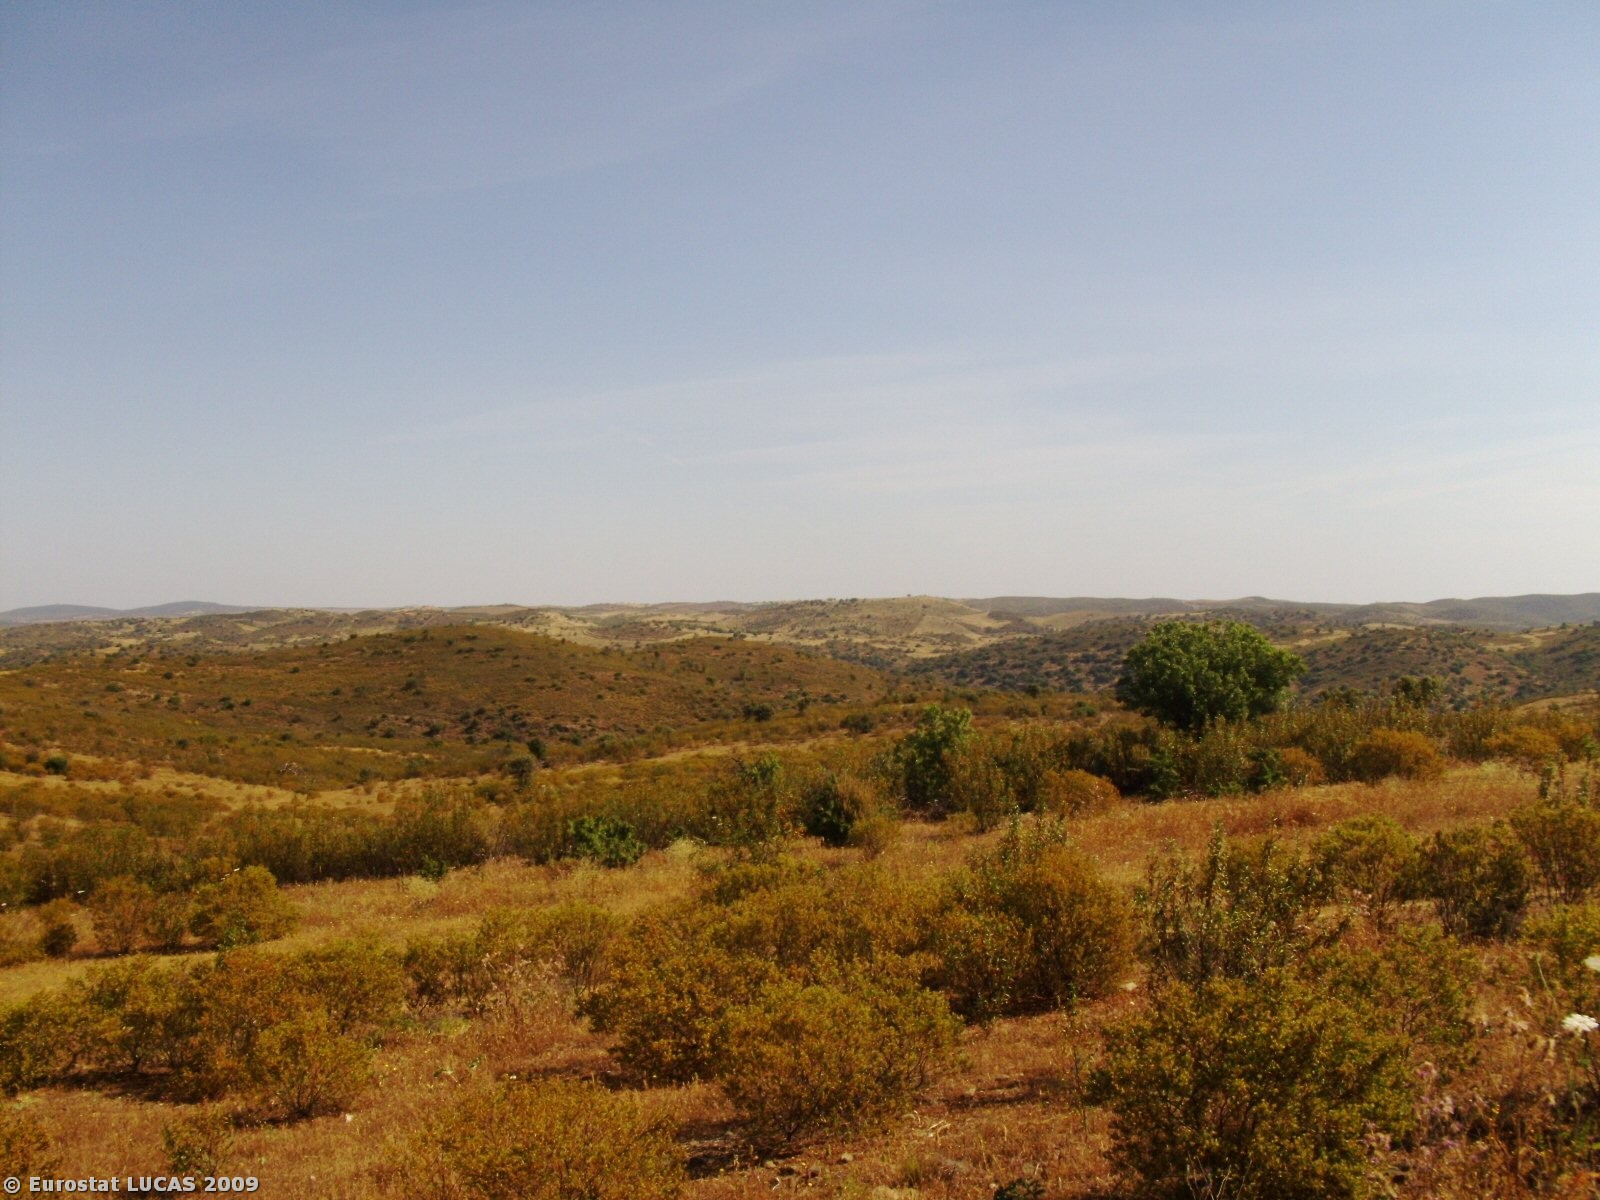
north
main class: Shrubland
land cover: Shrubland without tree cover
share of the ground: 50 - 75 %
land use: Nature reserves
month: May
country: PT
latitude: 37.5414
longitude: -7.5653
